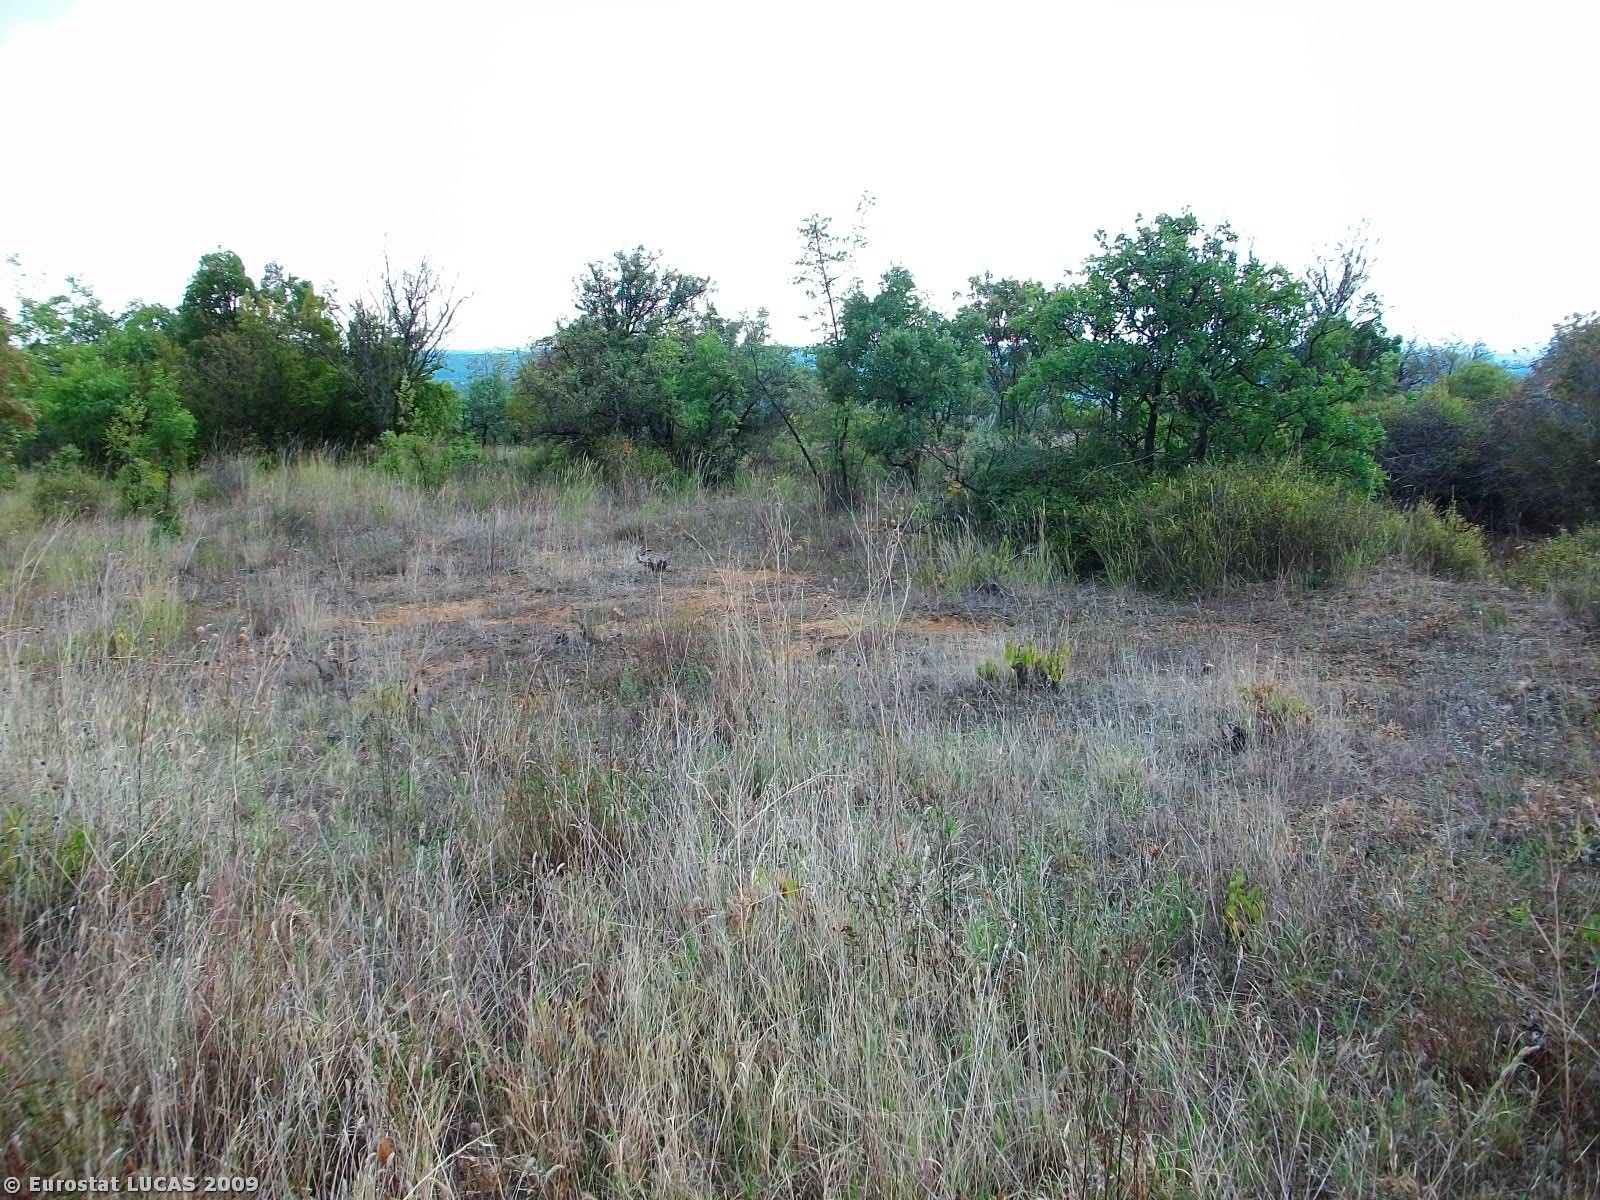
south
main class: Cropland
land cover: Vineyards
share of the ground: < 10 %
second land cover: Grassland with sparse tree/shrub cover
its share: > 75 %
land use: Fallow land
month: September
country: GR
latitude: 41.2751
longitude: 26.3683
